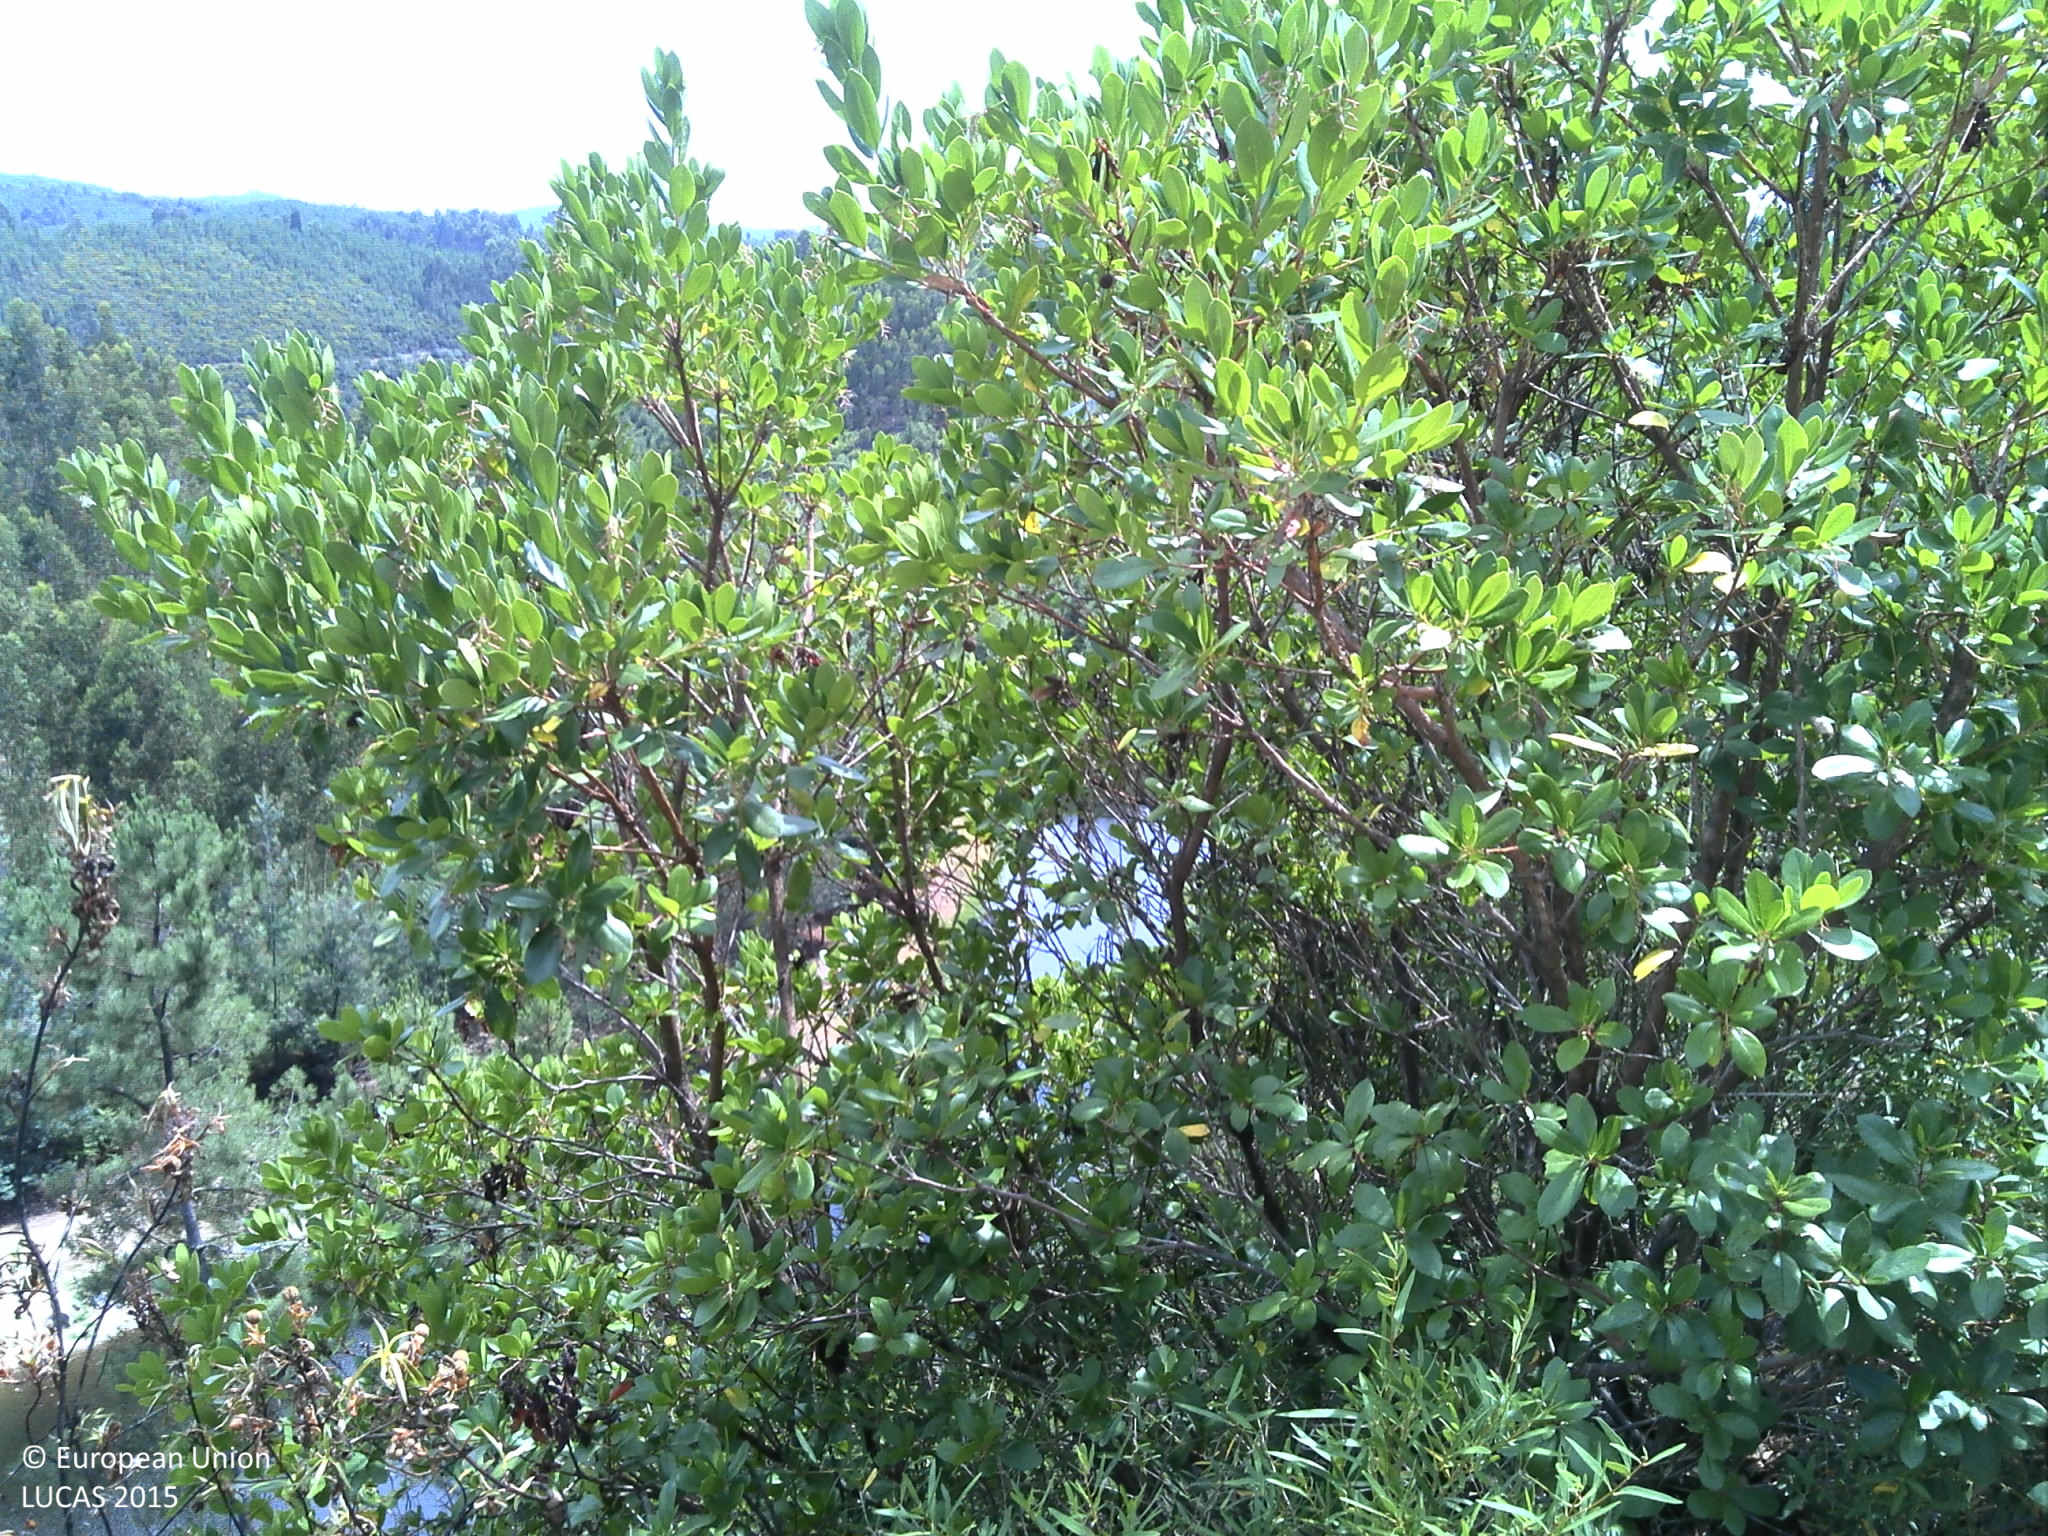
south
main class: Shrubland
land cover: Shrubland with sparse tree cover
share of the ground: 25 - 50 %
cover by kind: shrubs 35 %, consolidated bare surface 30 %, unconsolidated bare surface 30 %, broadleaved forest trees 5 %
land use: Semi-natural and natural areas not in use
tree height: < 5 m
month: July
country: PT
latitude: 39.8604
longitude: -8.0094
